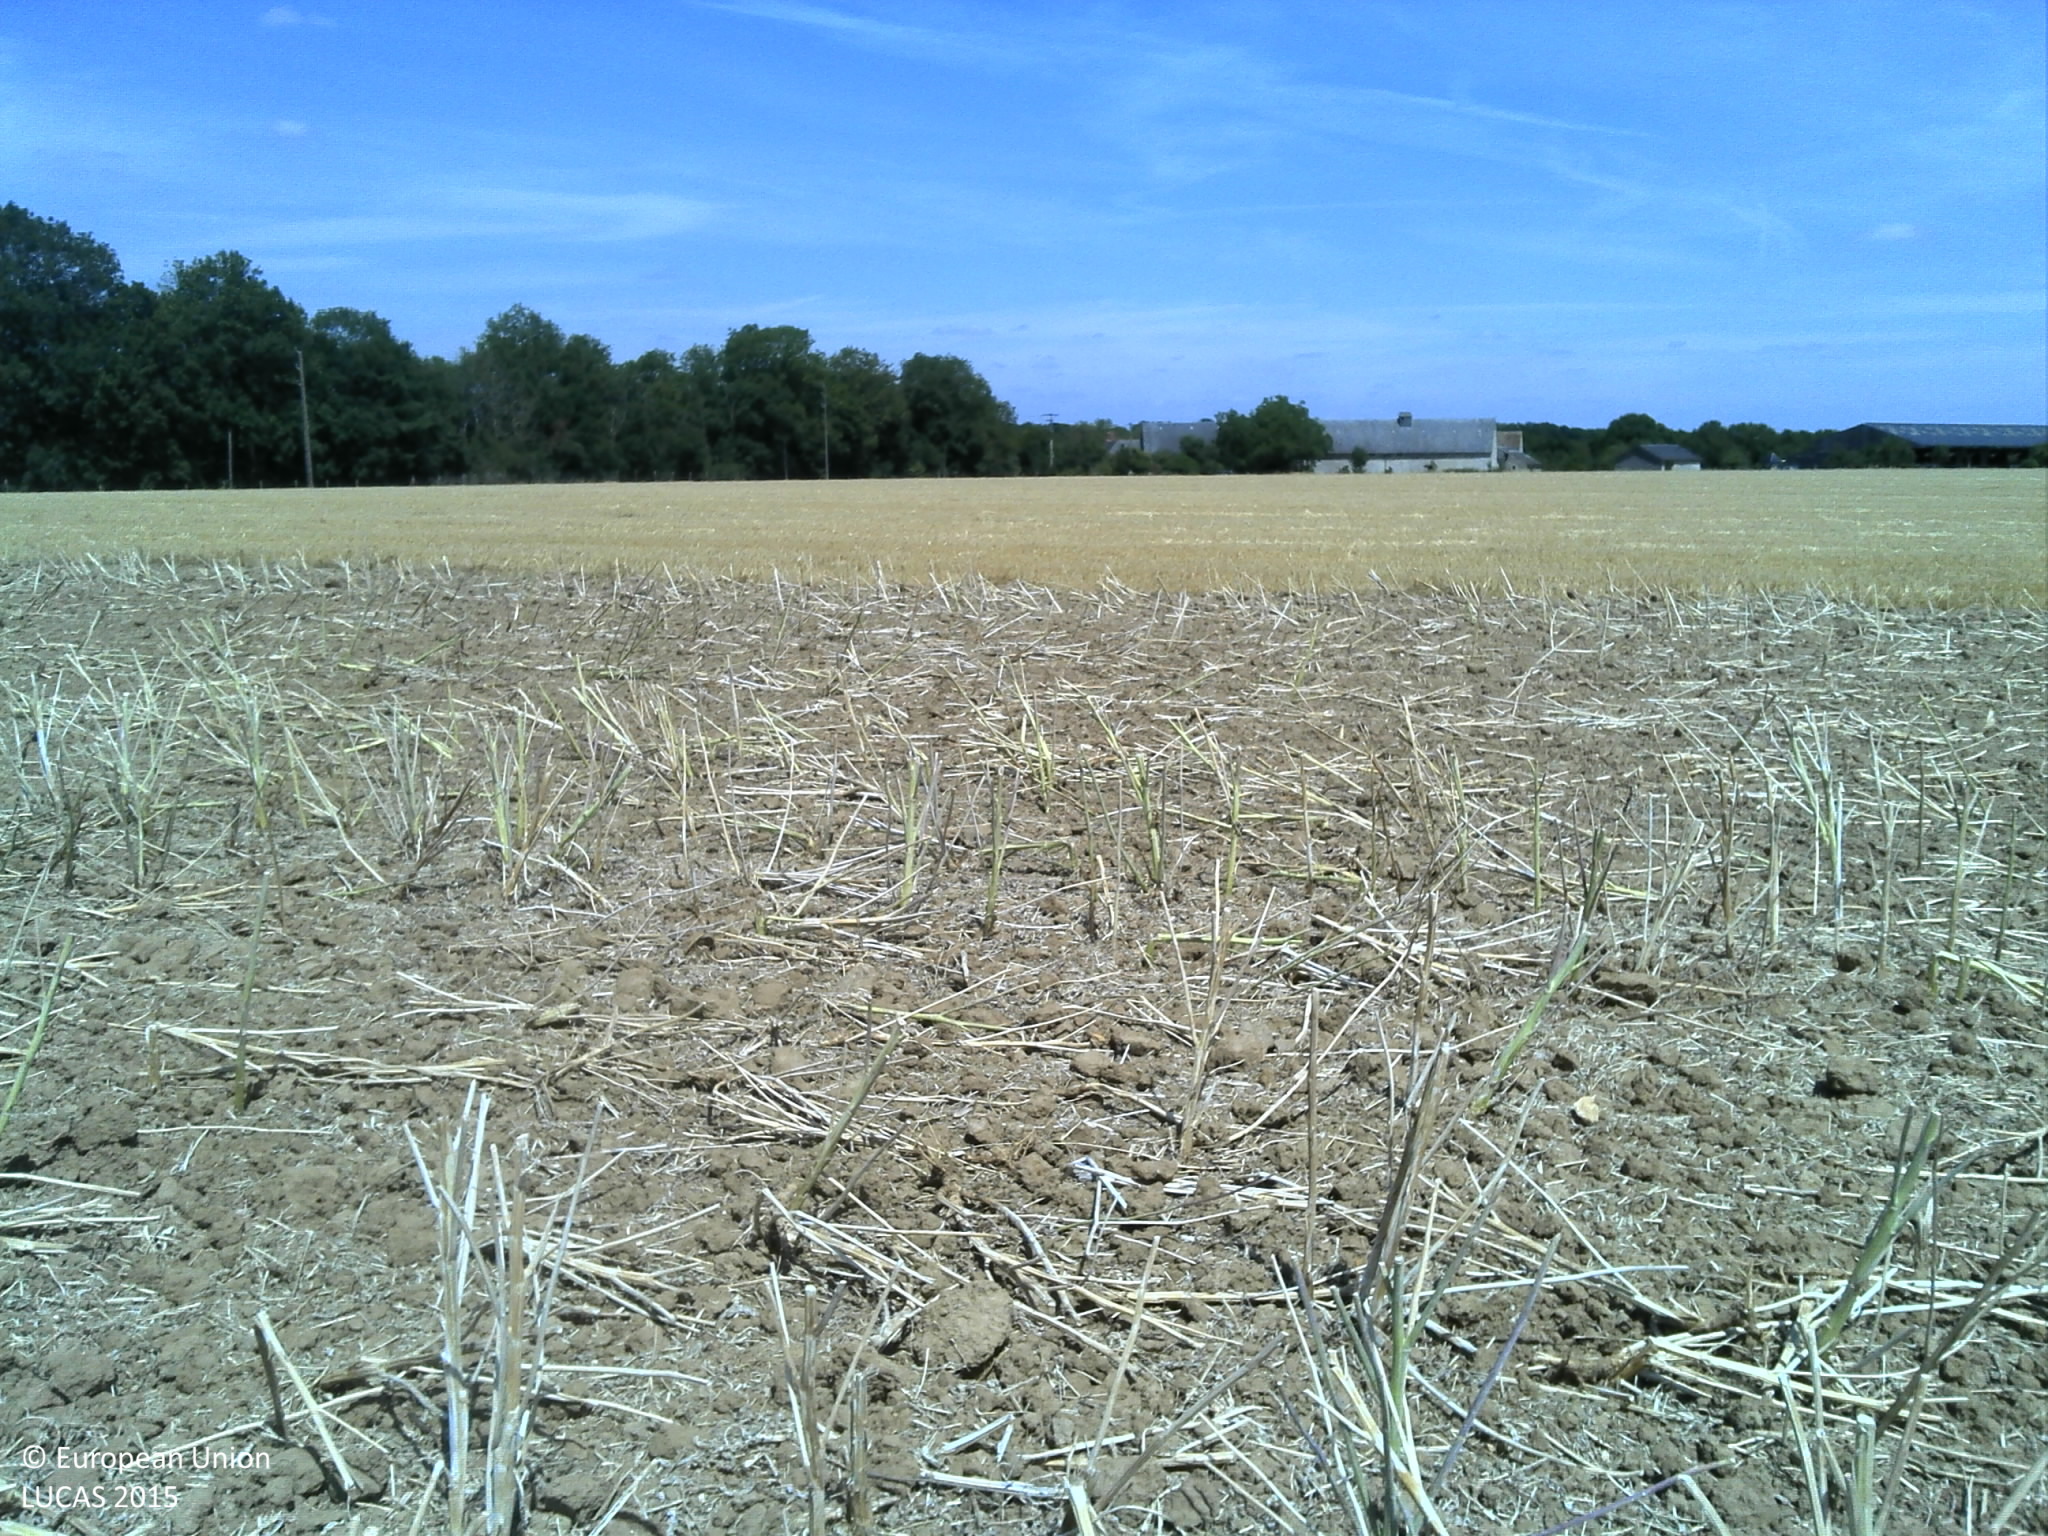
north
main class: Cropland
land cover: Rape and turnip rape
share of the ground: 10 - 25 %
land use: Agriculture (excluding fallow land and kitchen gardens)
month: July
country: FR
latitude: 48.5062
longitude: 1.9325
